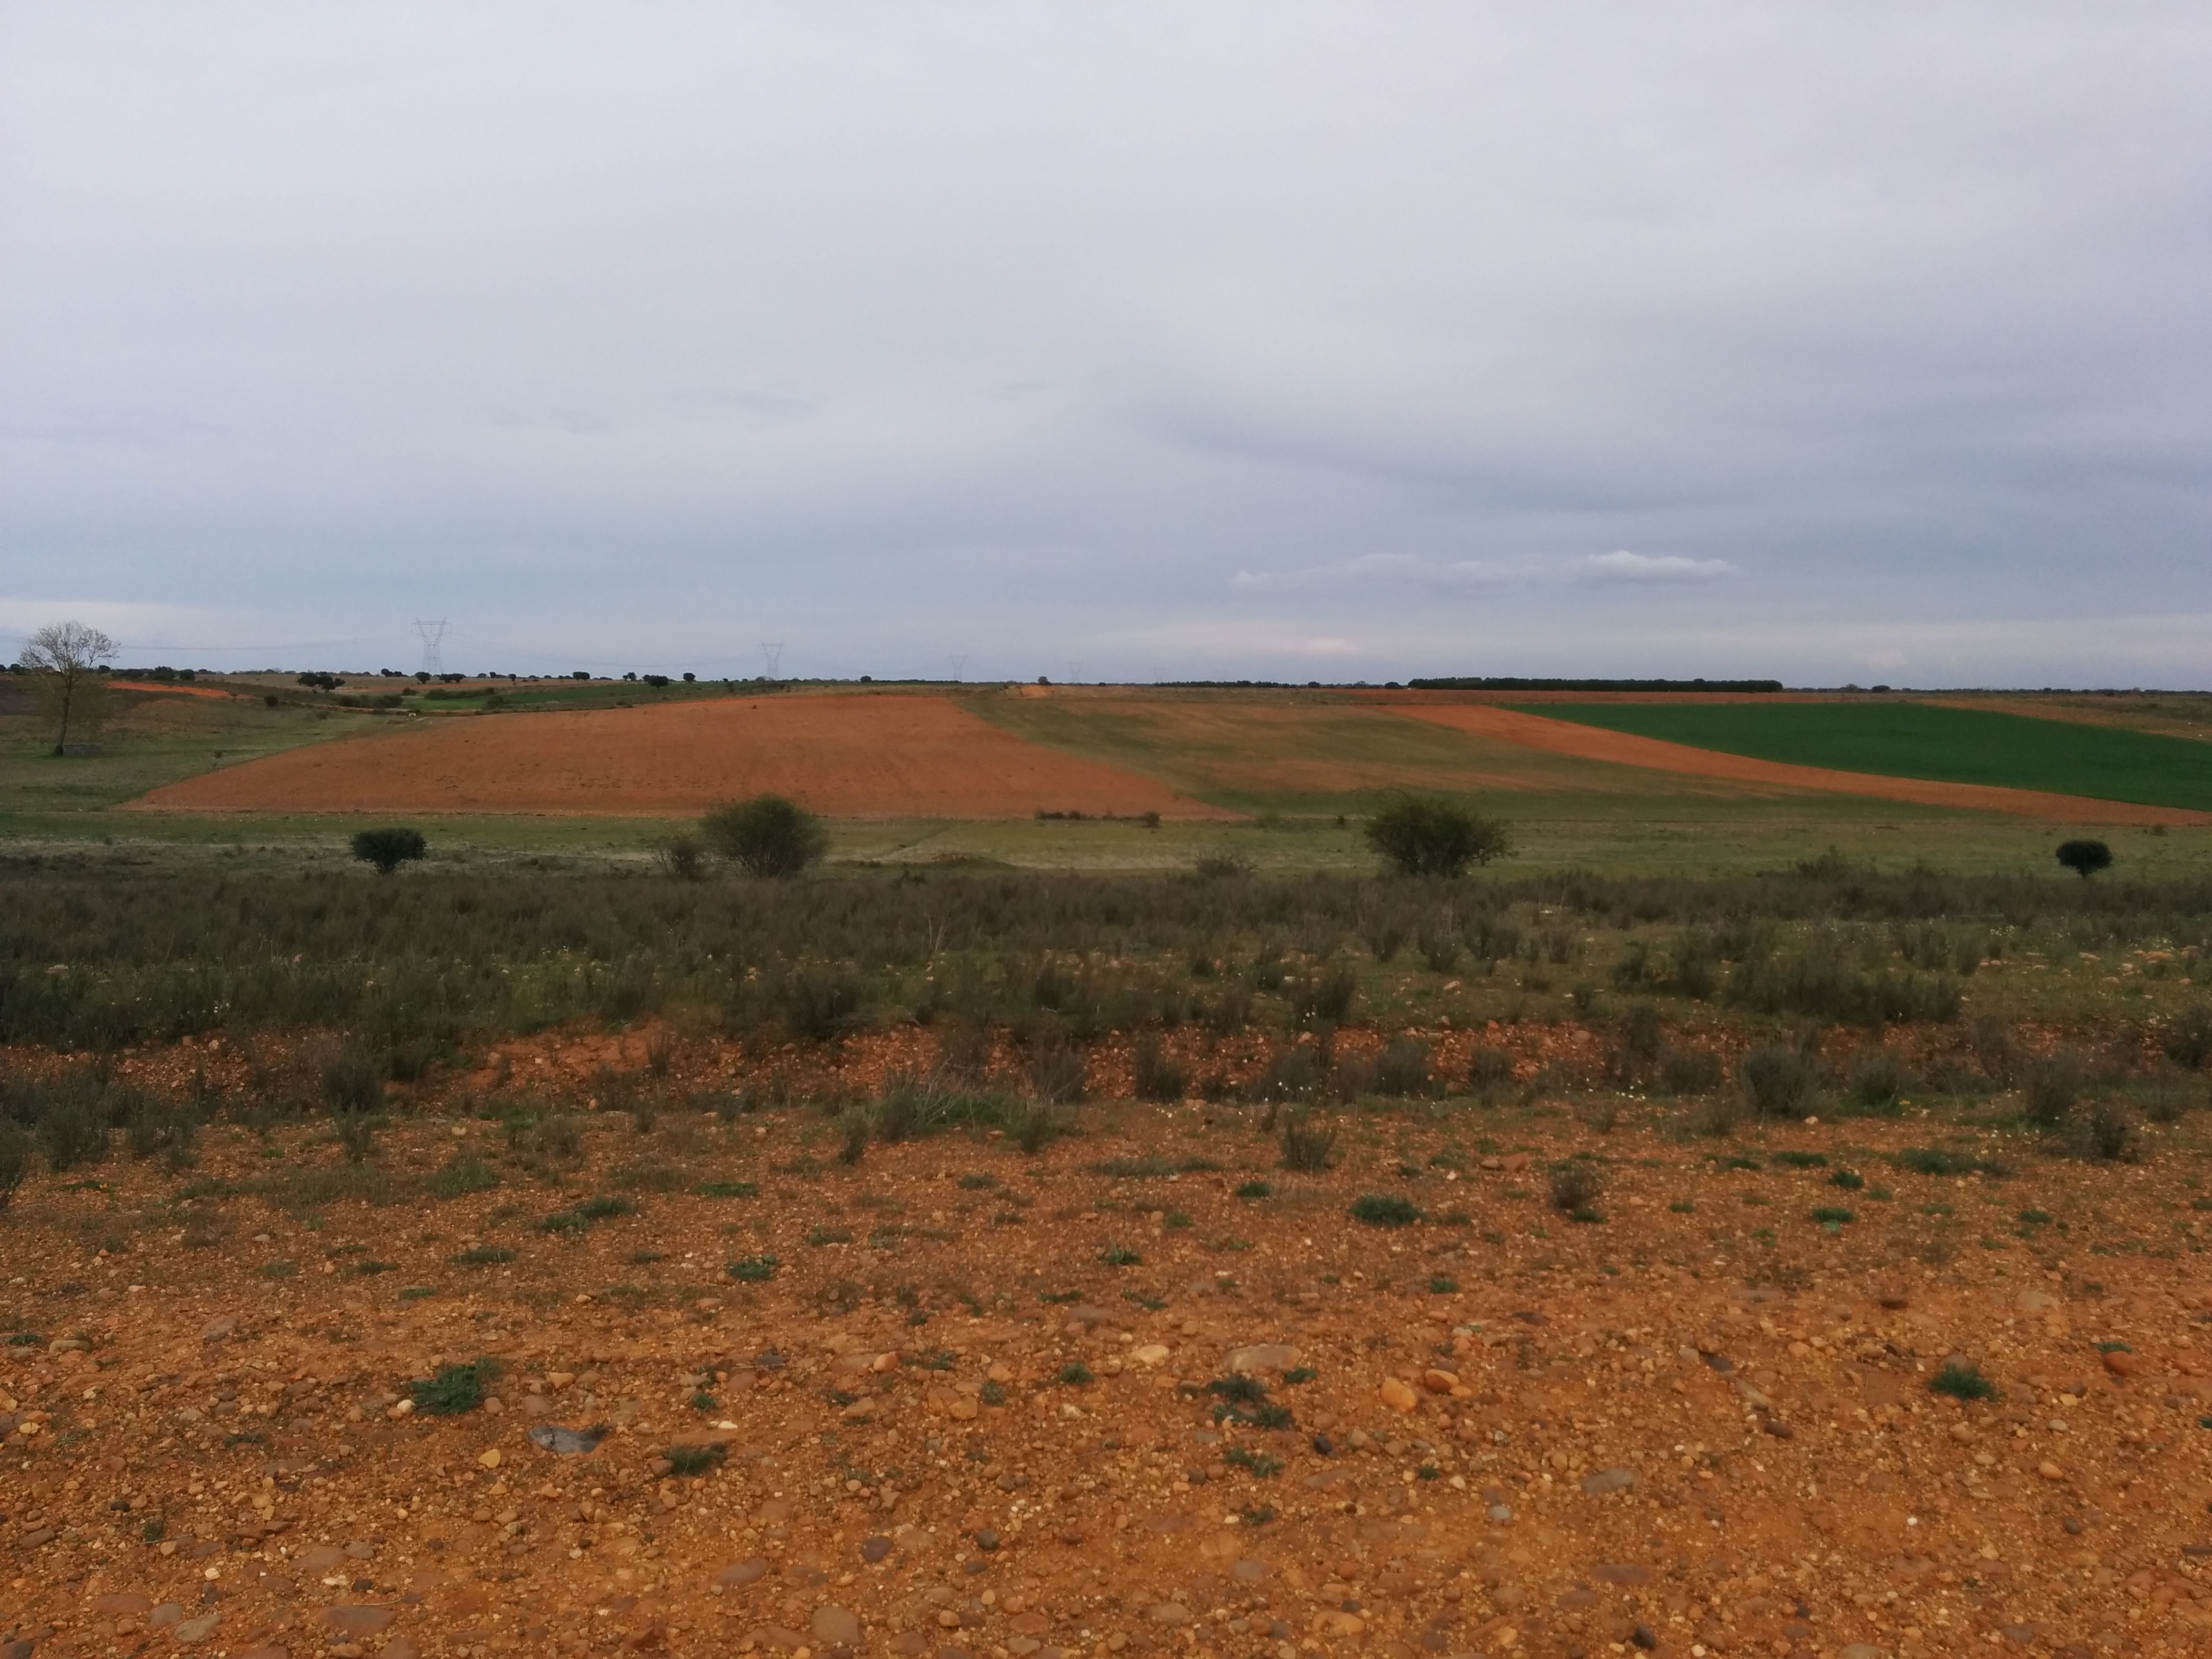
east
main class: Grassland
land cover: Grassland without tree/shrub cover
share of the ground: 25 - 50 %
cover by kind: unconsolidated bare surface 55 %, herbaceous plants 25 %, consolidated bare surface 15 %, shrubs 5 %
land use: Agriculture (excluding fallow land and kitchen gardens)
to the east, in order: Grass margins; Tracks; Grassland without tree/shrub cover; Shrubland without tree cover; Grassland with sparse tree/shrub cover; Grassland without tree/shrub cover; Other bare soil; Spontaneously vegetated surfaces
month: April
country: ES
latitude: 42.4670
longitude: -5.7023
